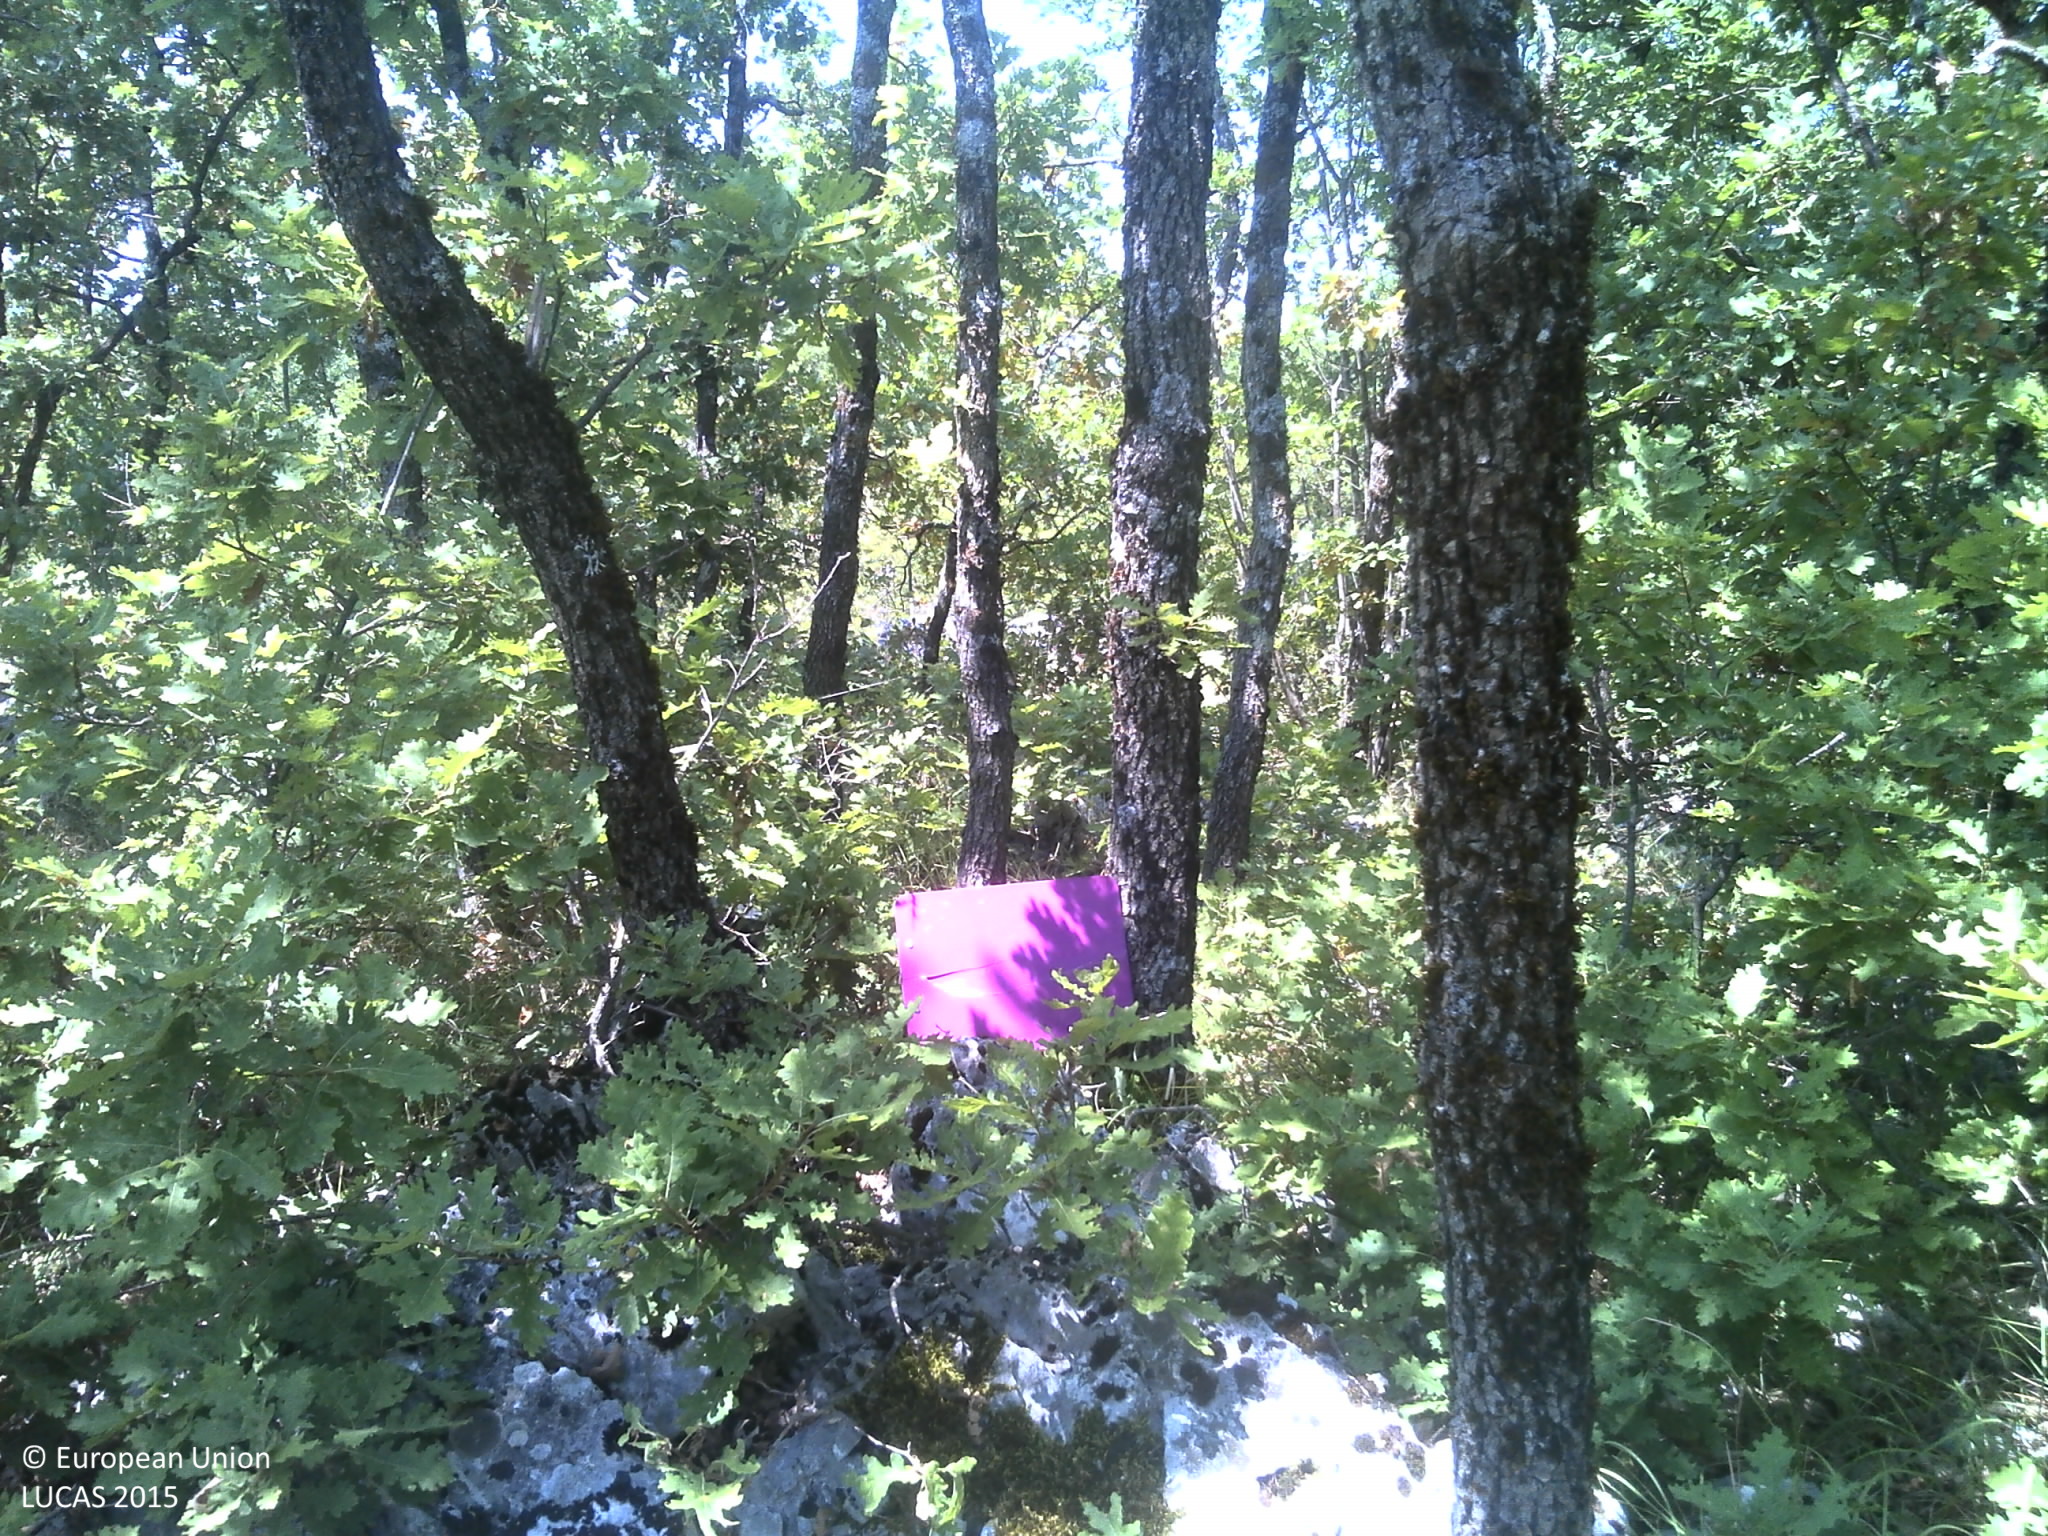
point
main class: Woodland
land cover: Broadleaved woodland
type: thermophilous deciduous forest
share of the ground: > 75 %
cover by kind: broadleaved forest trees 70 %, shrubs 10 %, herbaceous plants 5 %, lichens and mosses 5 %, consolidated bare surface 5 %, unconsolidated bare surface 5 %
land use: Semi-natural and natural areas not in use
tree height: > 5 m
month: July
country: HR
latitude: 43.4632
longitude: 17.2474
